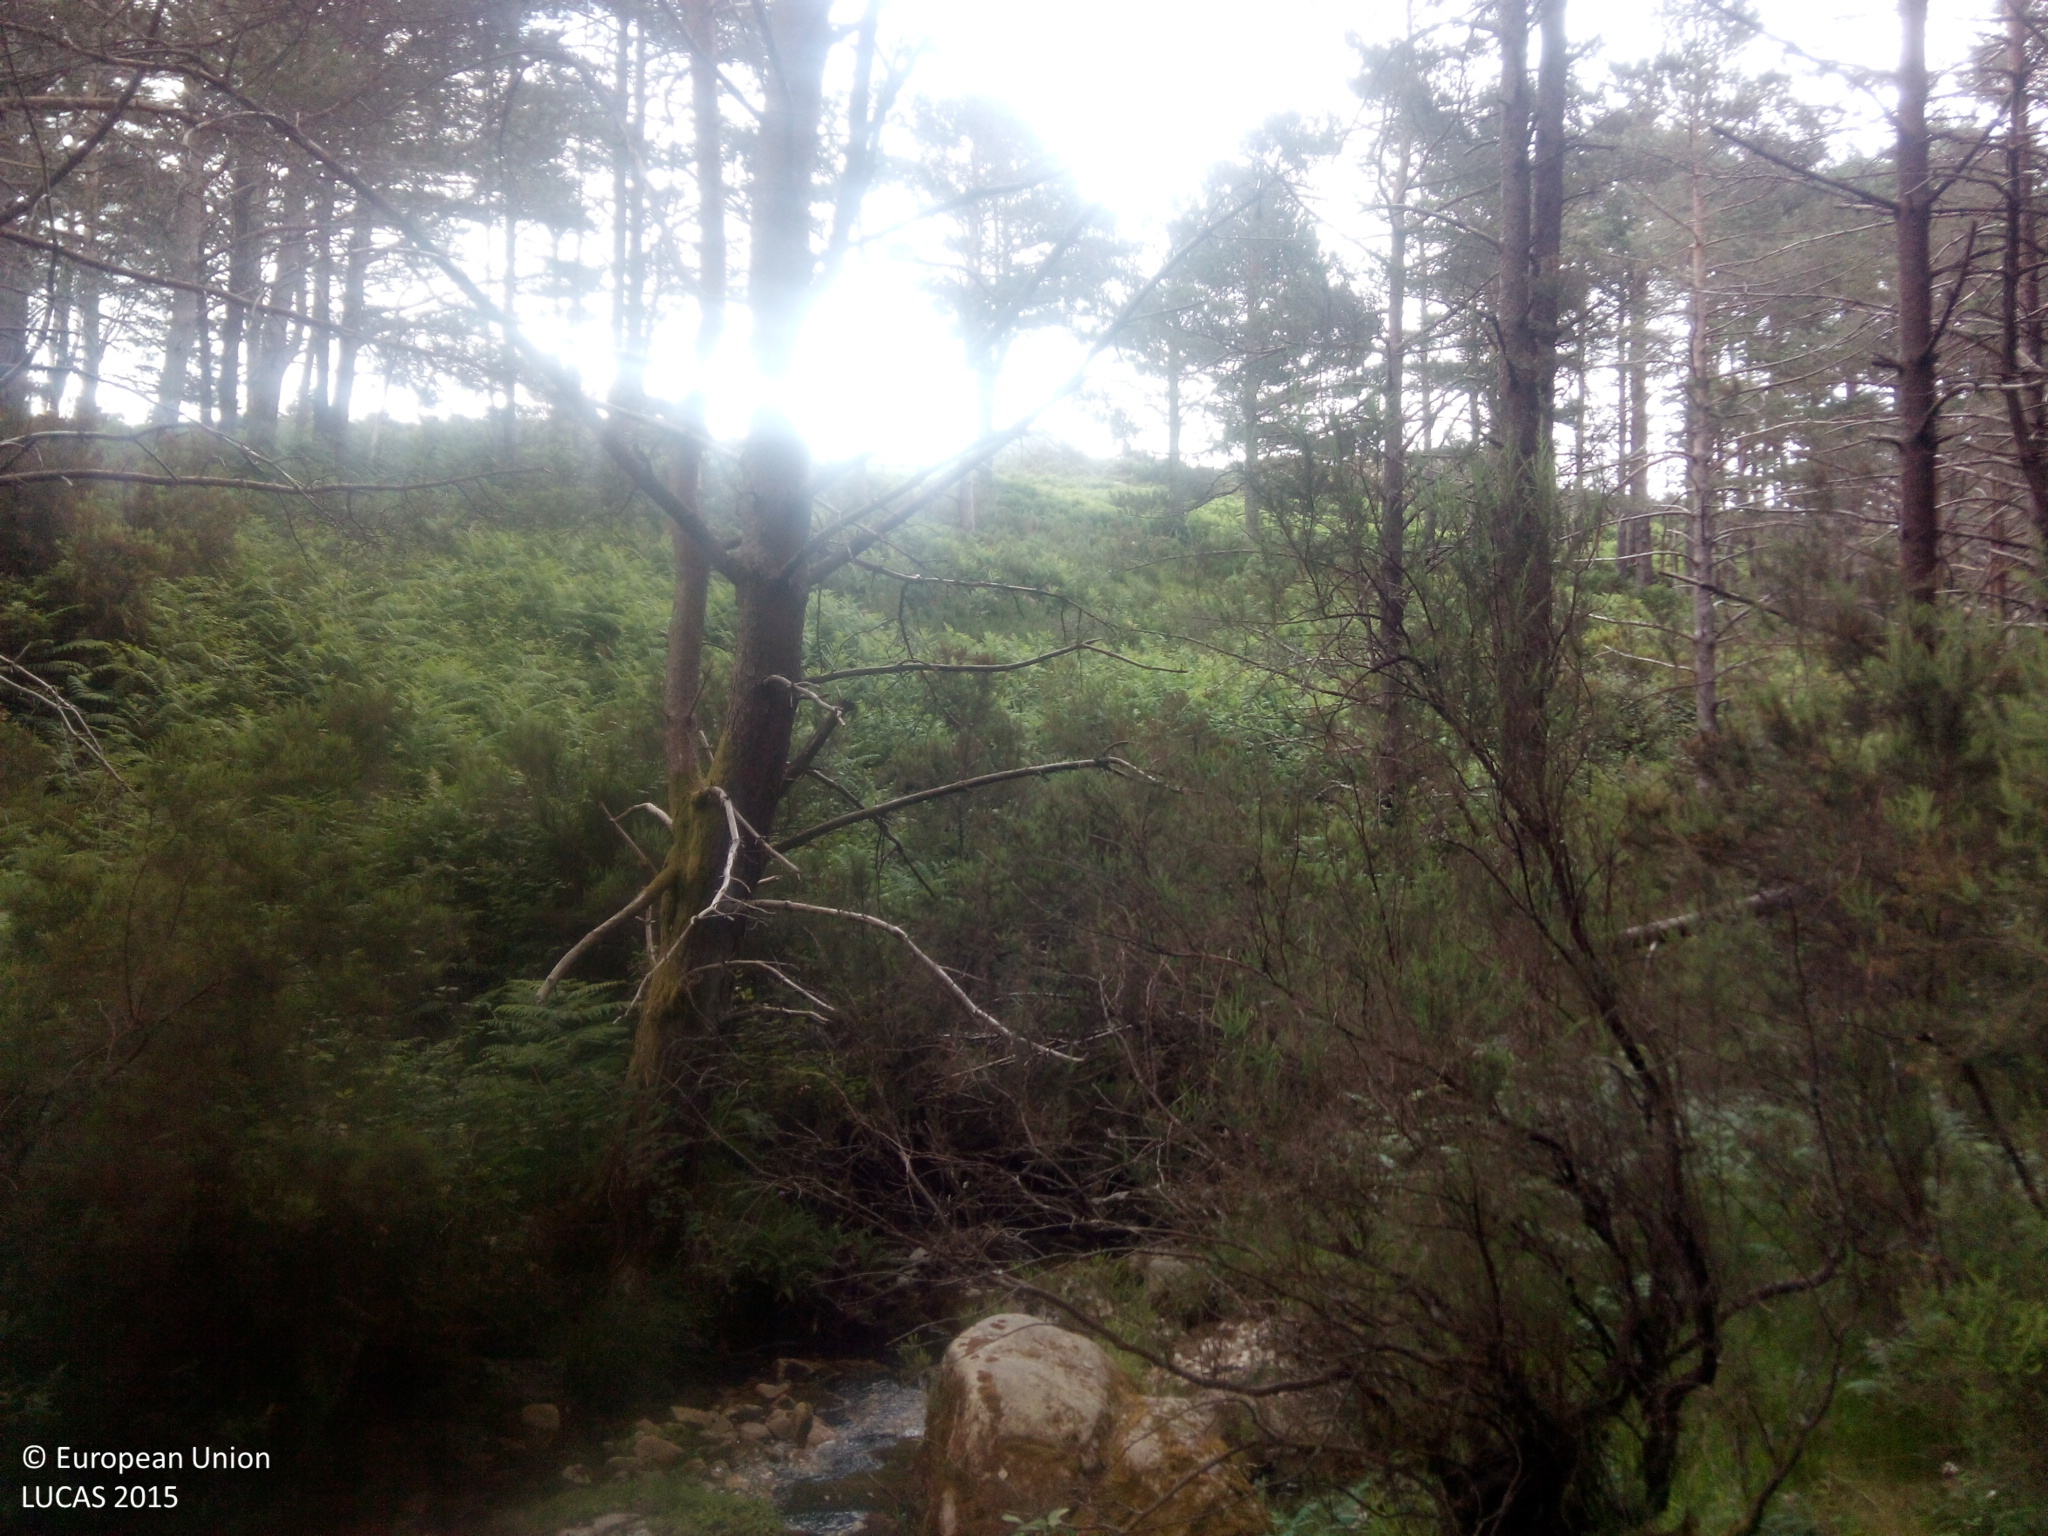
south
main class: Woodland
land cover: Pine dominated coniferous woodland
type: exotic forest
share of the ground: > 75 %
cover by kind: coniferous forest trees 100 %
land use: Forestry
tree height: > 5 m
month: July
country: ES
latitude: 42.3091
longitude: -8.2490
